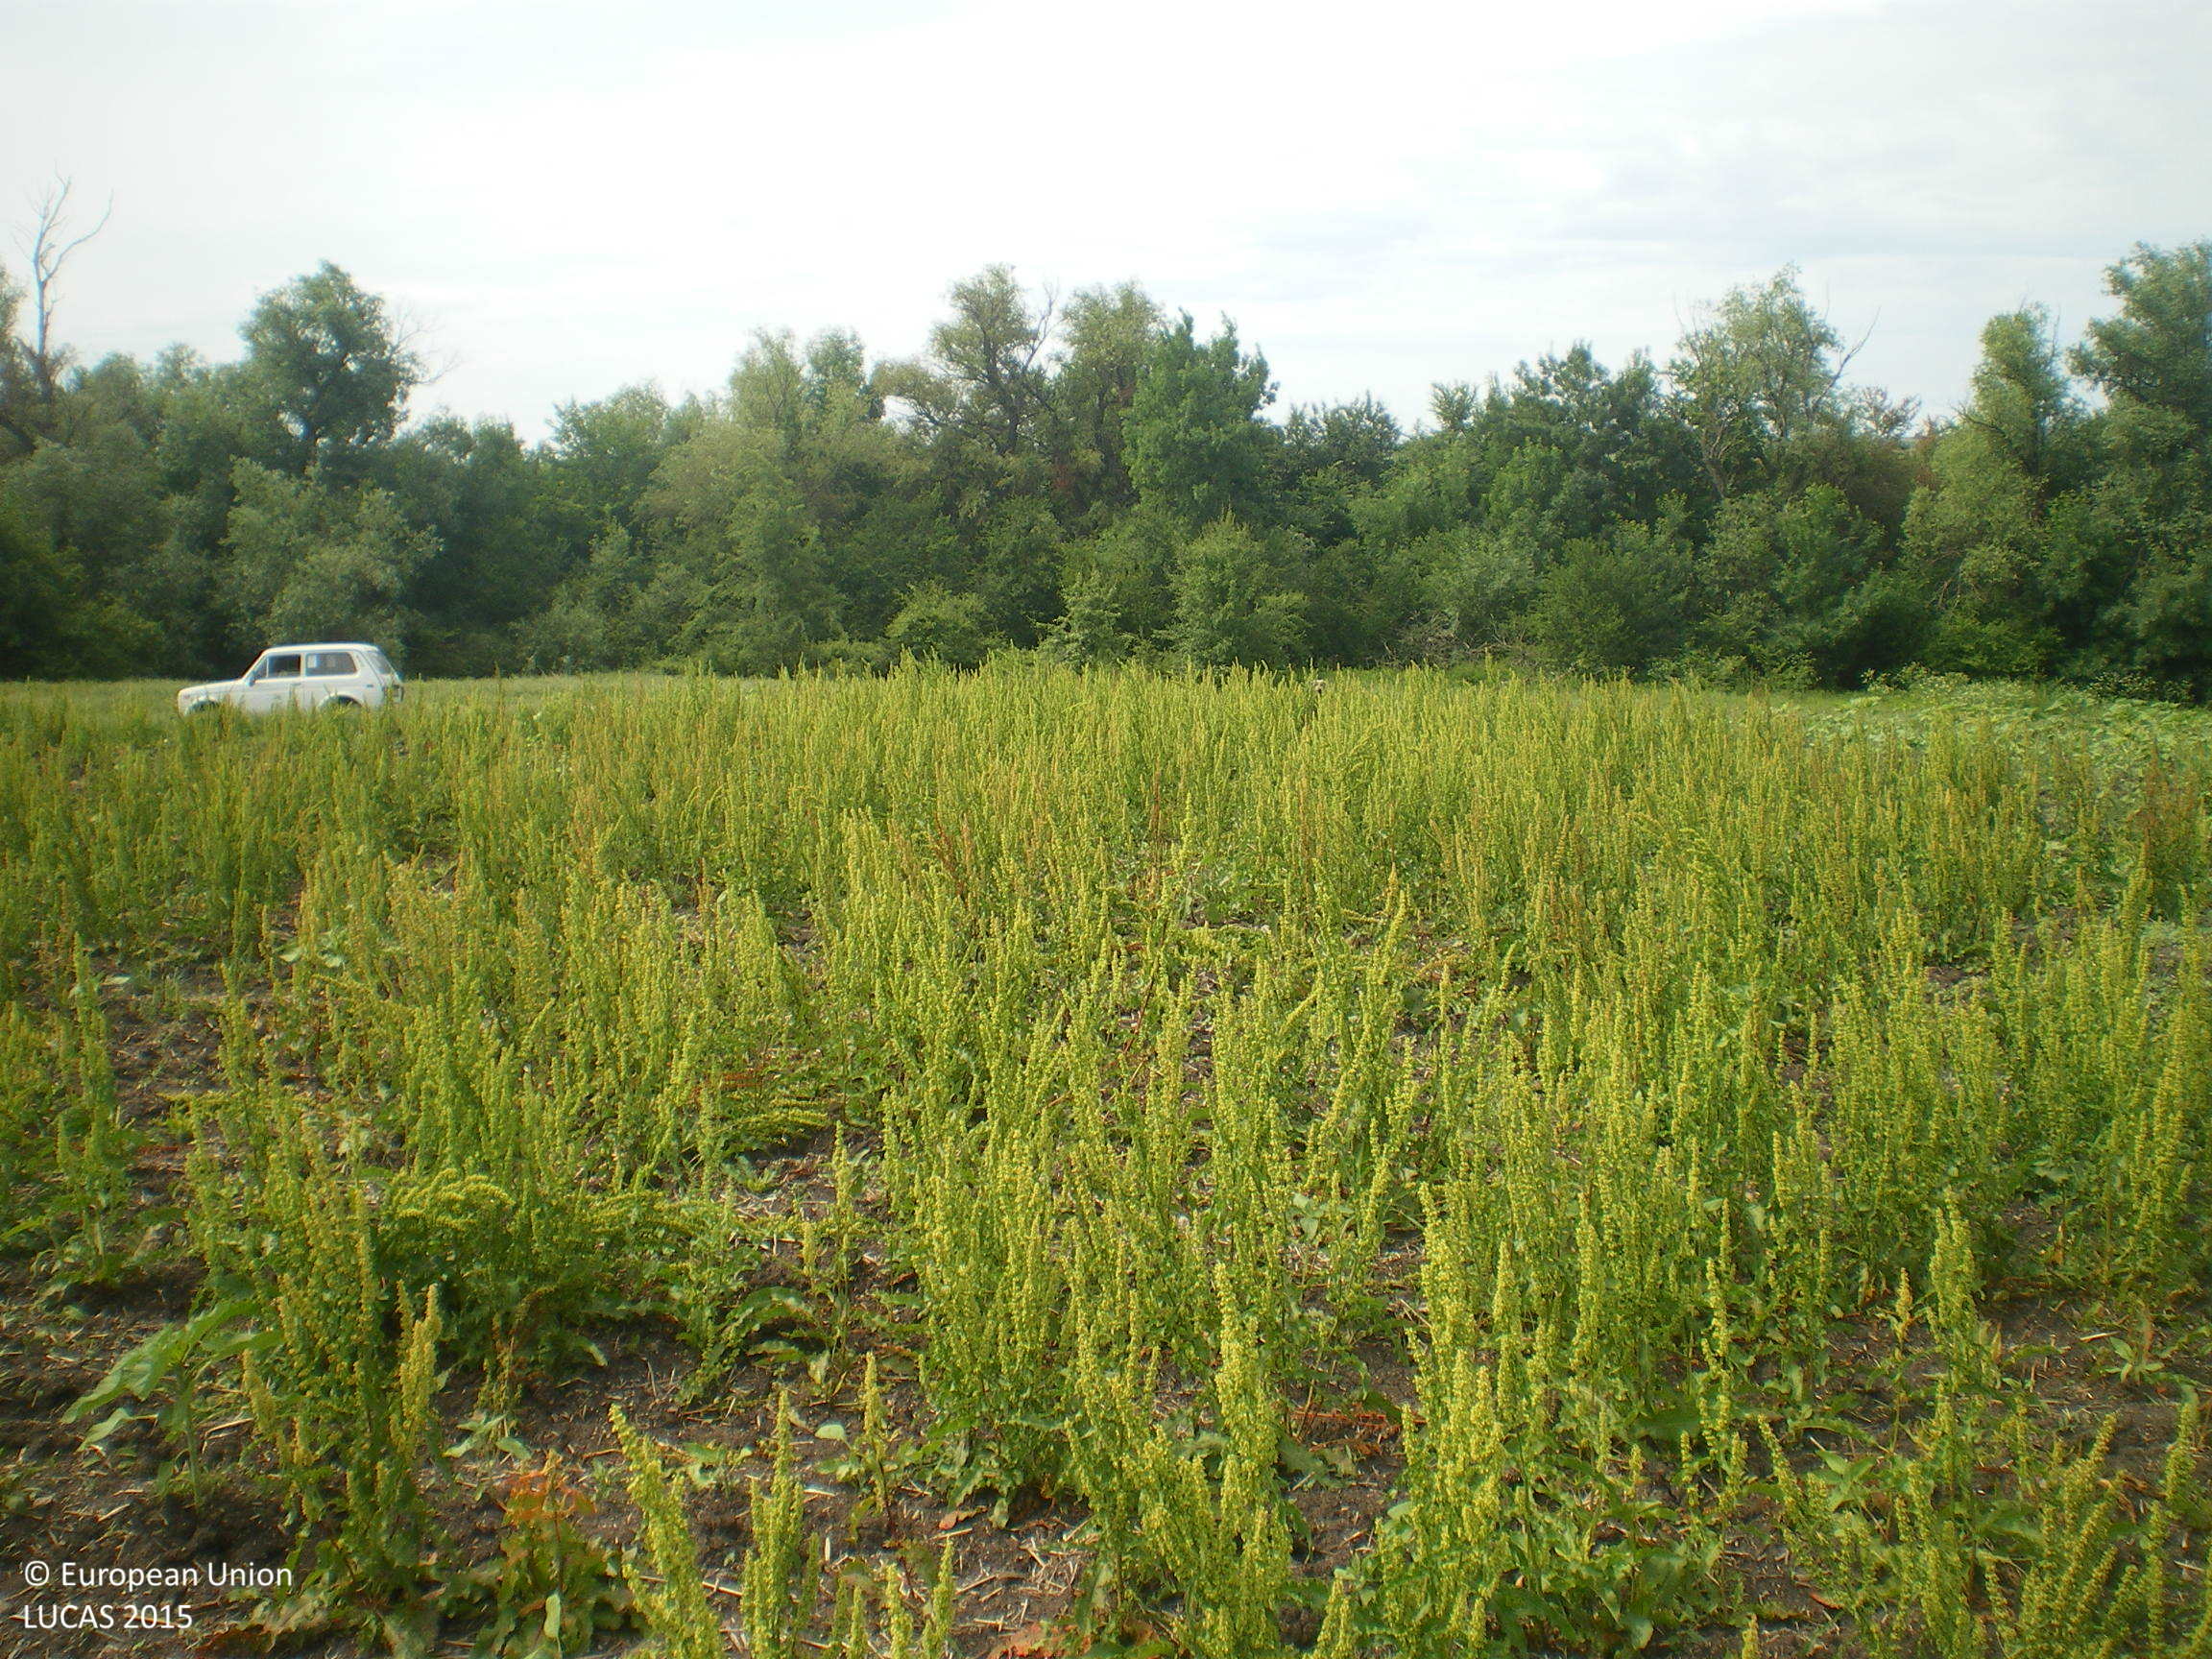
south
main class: Grassland
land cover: Spontaneously vegetated surfaces
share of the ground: > 75 %
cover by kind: herbaceous plants 100 %
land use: Fallow land
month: June
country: BG
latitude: 42.0383
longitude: 25.3919
